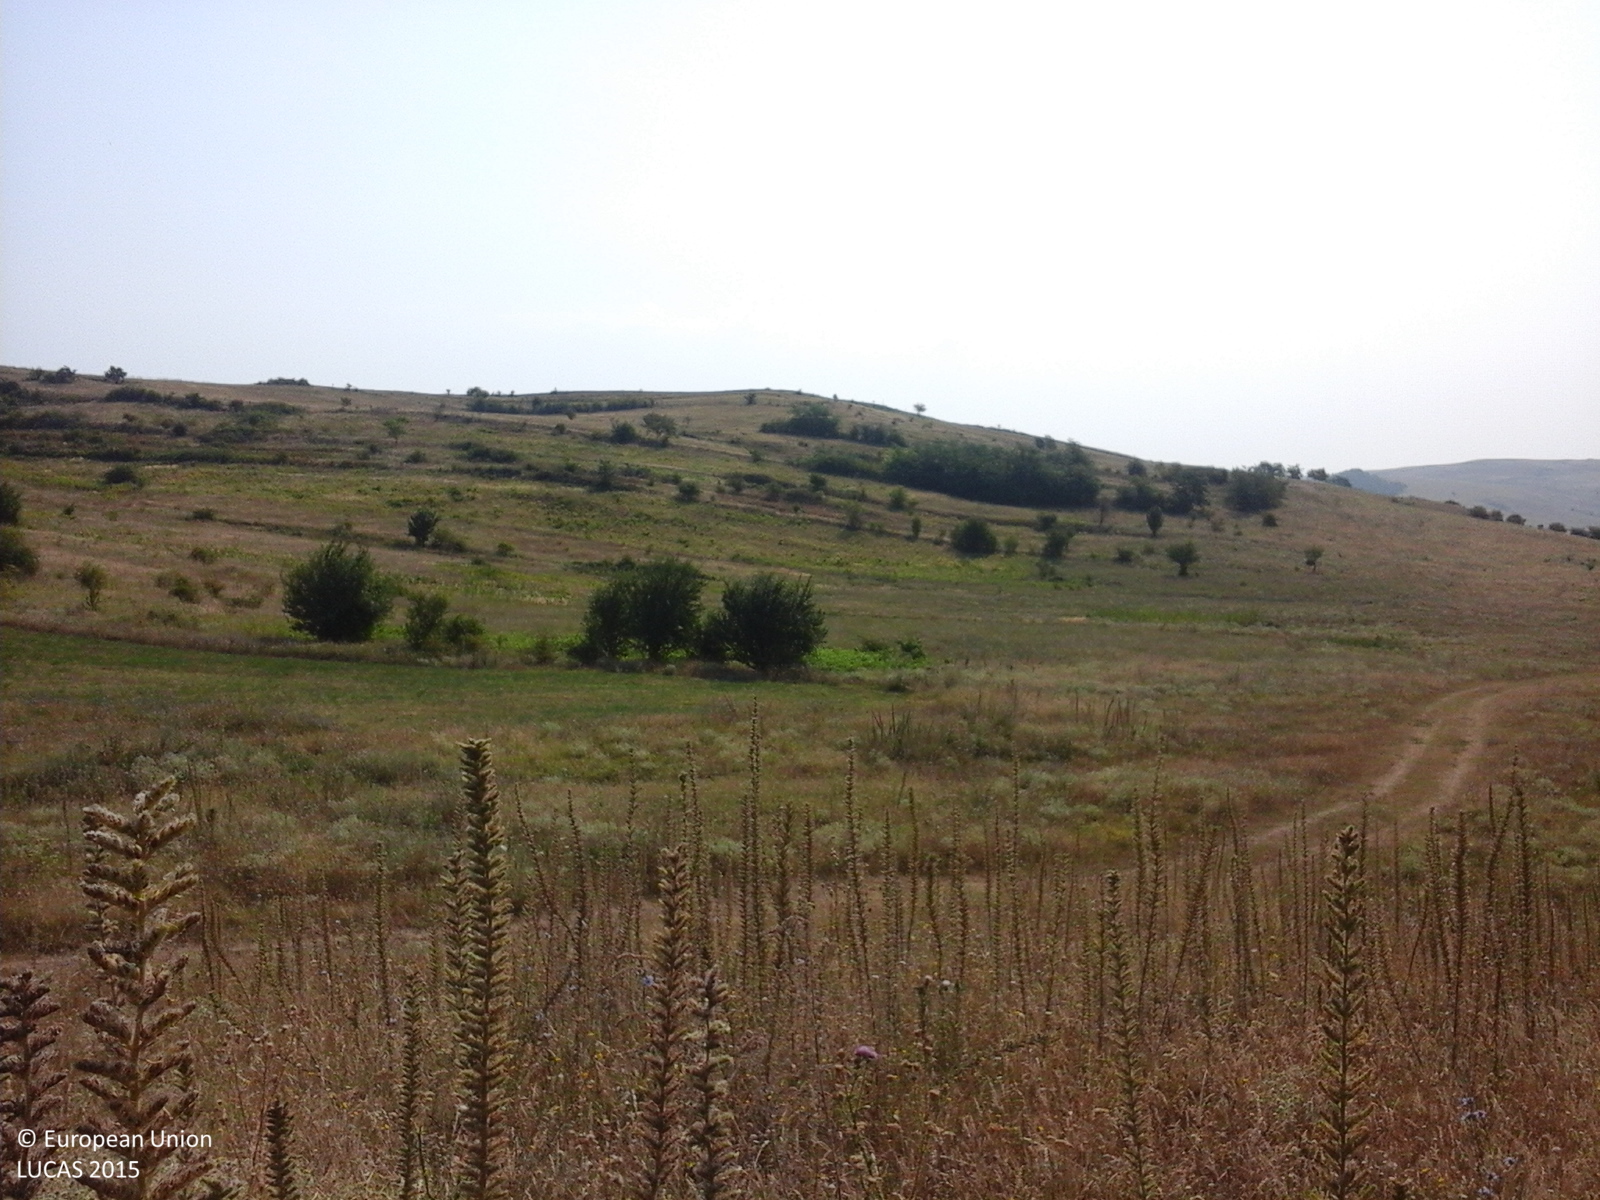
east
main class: Grassland
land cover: Spontaneously vegetated surfaces
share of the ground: > 75 %
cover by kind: herbaceous plants 100 %
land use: Agriculture (excluding fallow land and kitchen gardens)
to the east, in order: Spontaneously vegetated surfaces; Tracks; Spontaneously vegetated surfaces; Tracks; Spontaneously vegetated surfaces; Lucerne; Abandoned hedges; Vineyards; Spontaneously vegetated surfaces; Maize; Ditches and canals; Managed hedges; Grassland without tree/shrub cover; Vineyards; Lines of trees; Grassland without tree/shrub cover
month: August
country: RO
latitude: 44.5341
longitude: 22.8417
